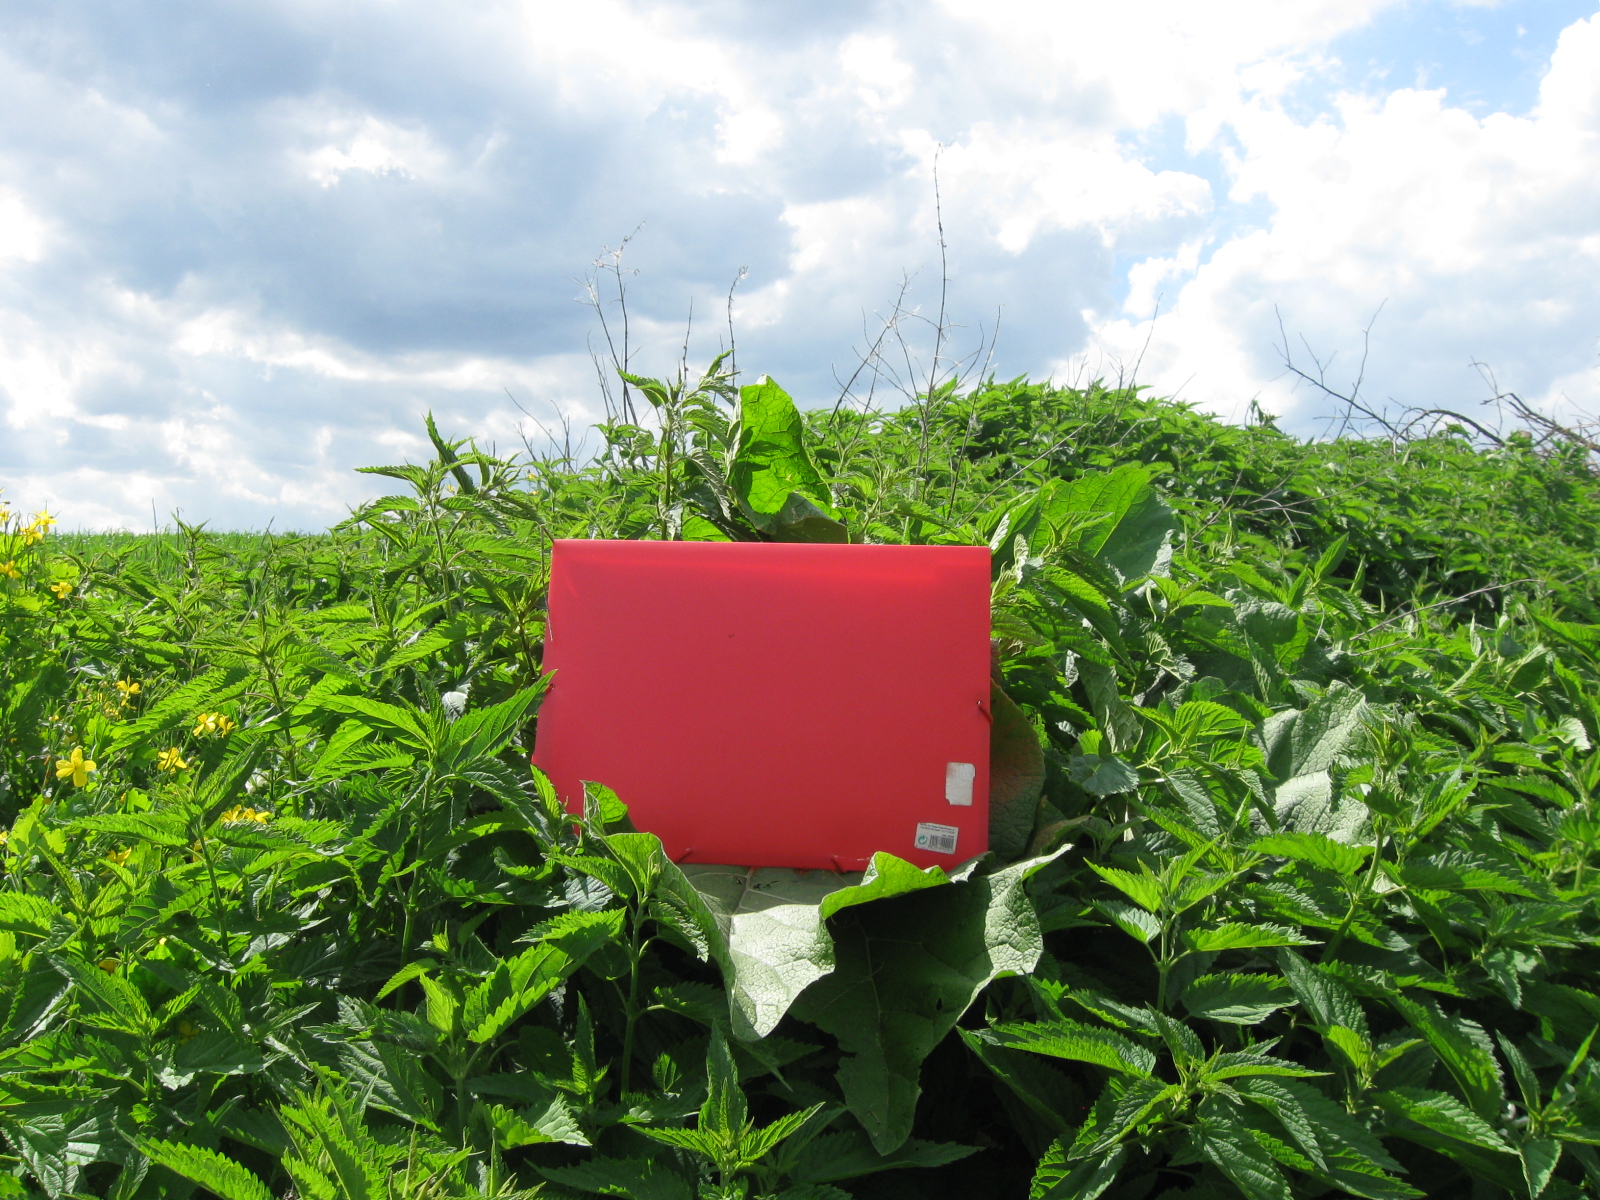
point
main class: Woodland
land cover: Broadleaved woodland
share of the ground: > 75 %
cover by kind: broadleaved forest trees 75 %, herbaceous plants 25 %
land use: Semi-natural and natural areas not in use
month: June
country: LT
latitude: 54.3244
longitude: 23.7876
